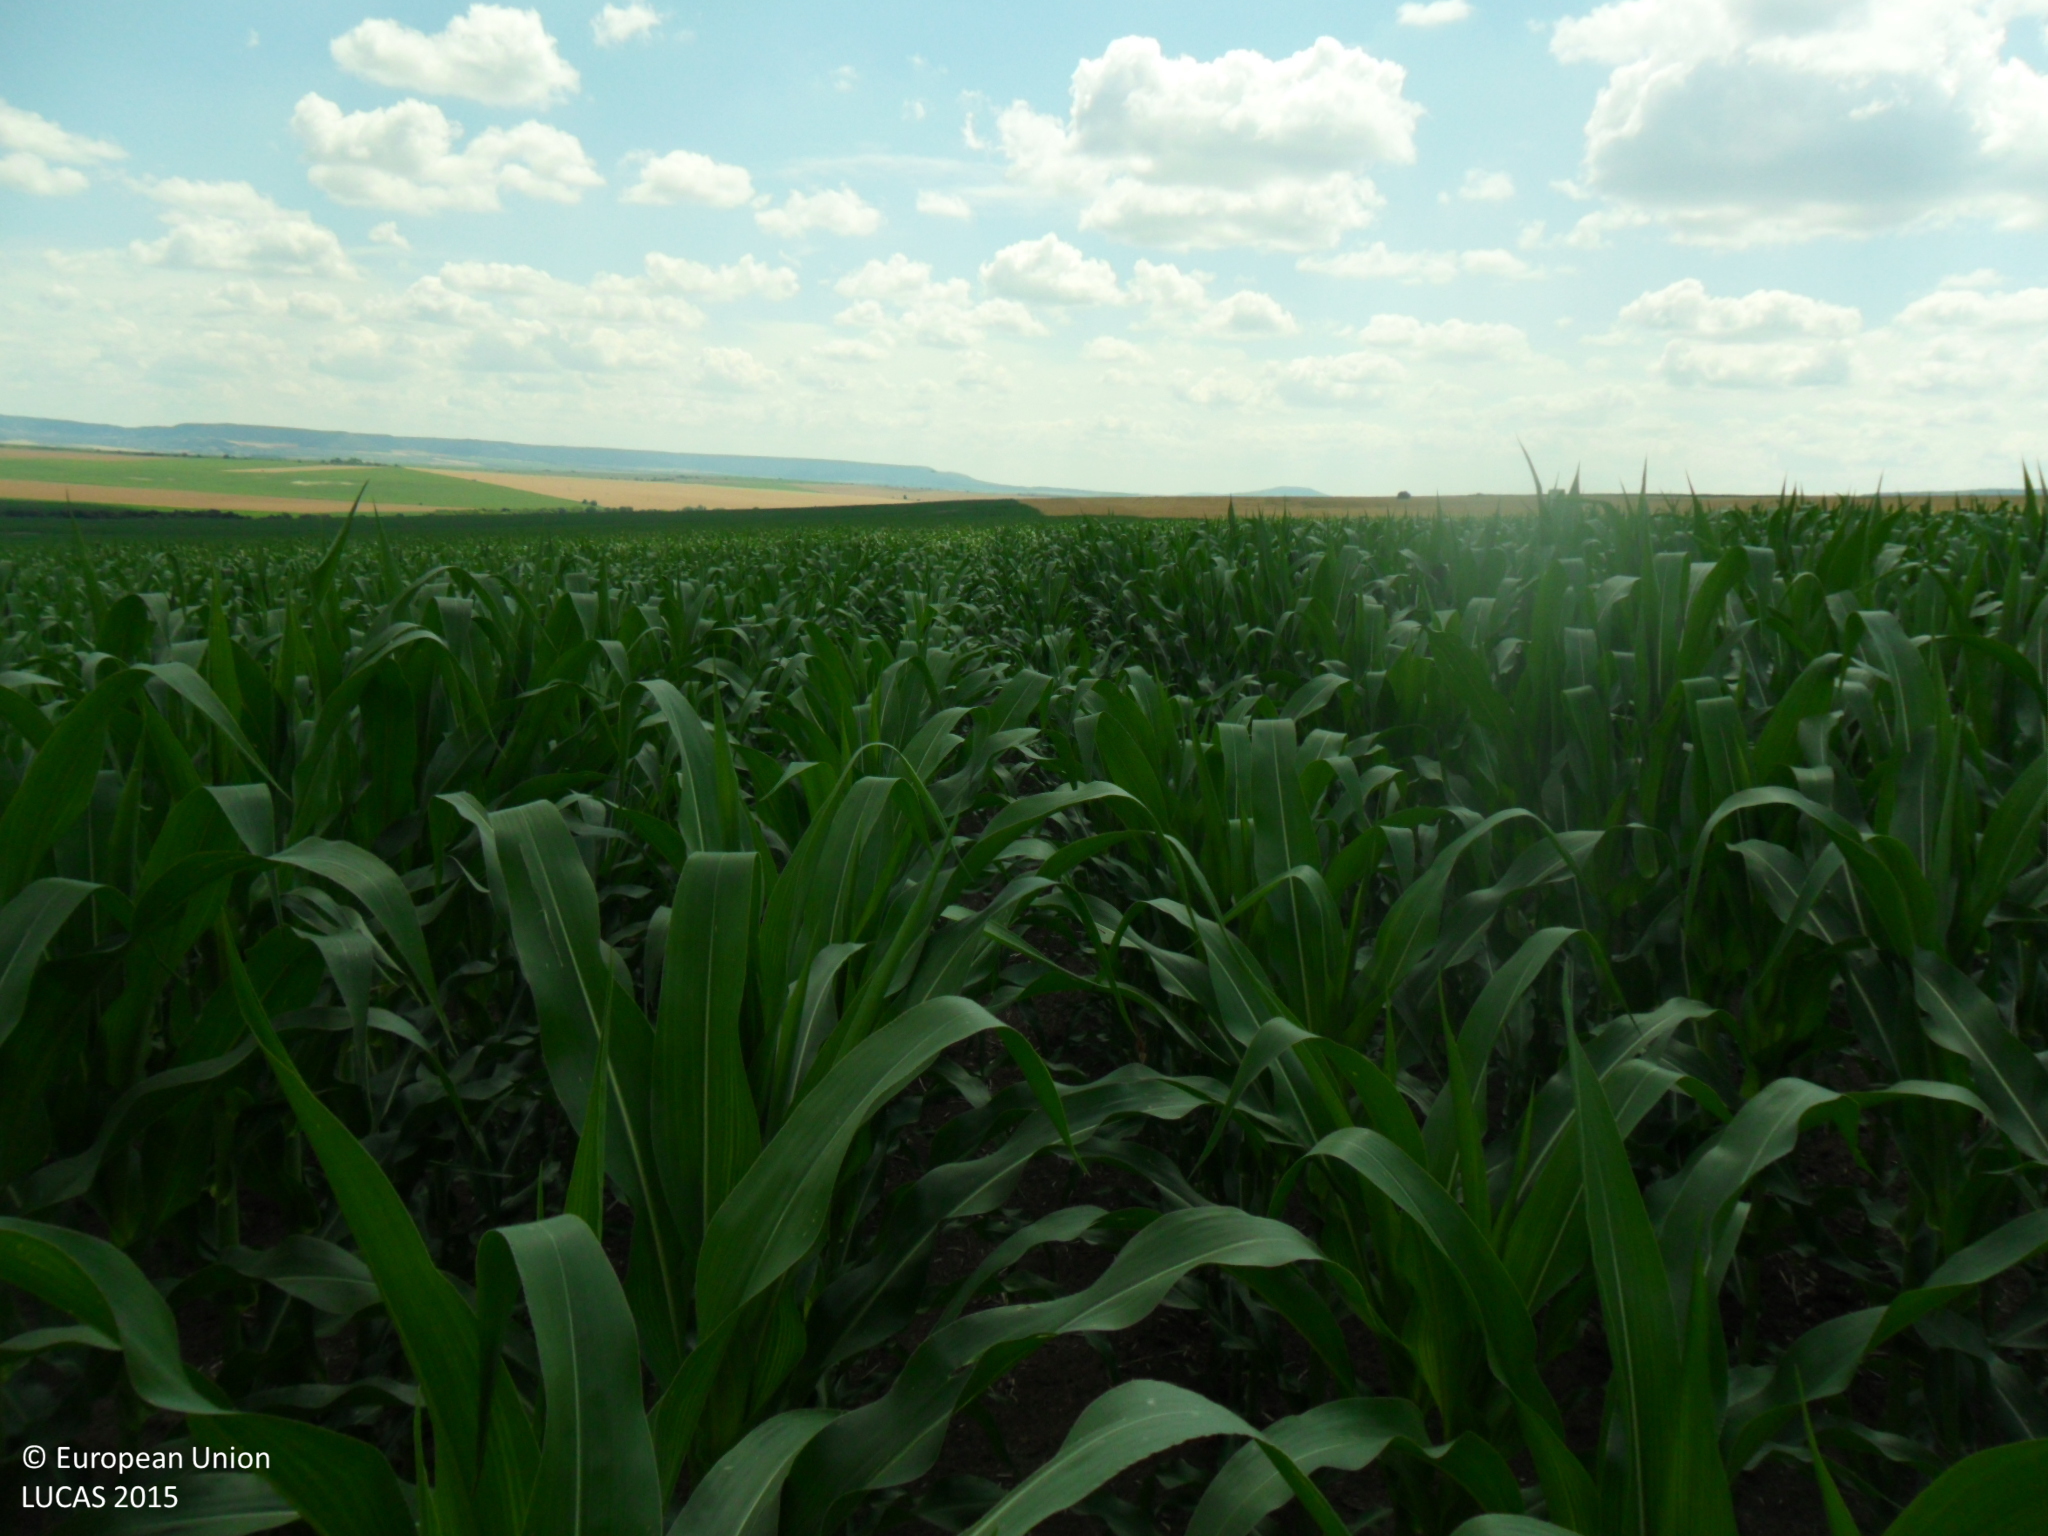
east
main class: Cropland
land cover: Maize
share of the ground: > 75 %
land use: Agriculture (excluding fallow land and kitchen gardens)
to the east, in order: Maize
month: June
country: BG
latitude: 43.3491
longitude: 27.0555
